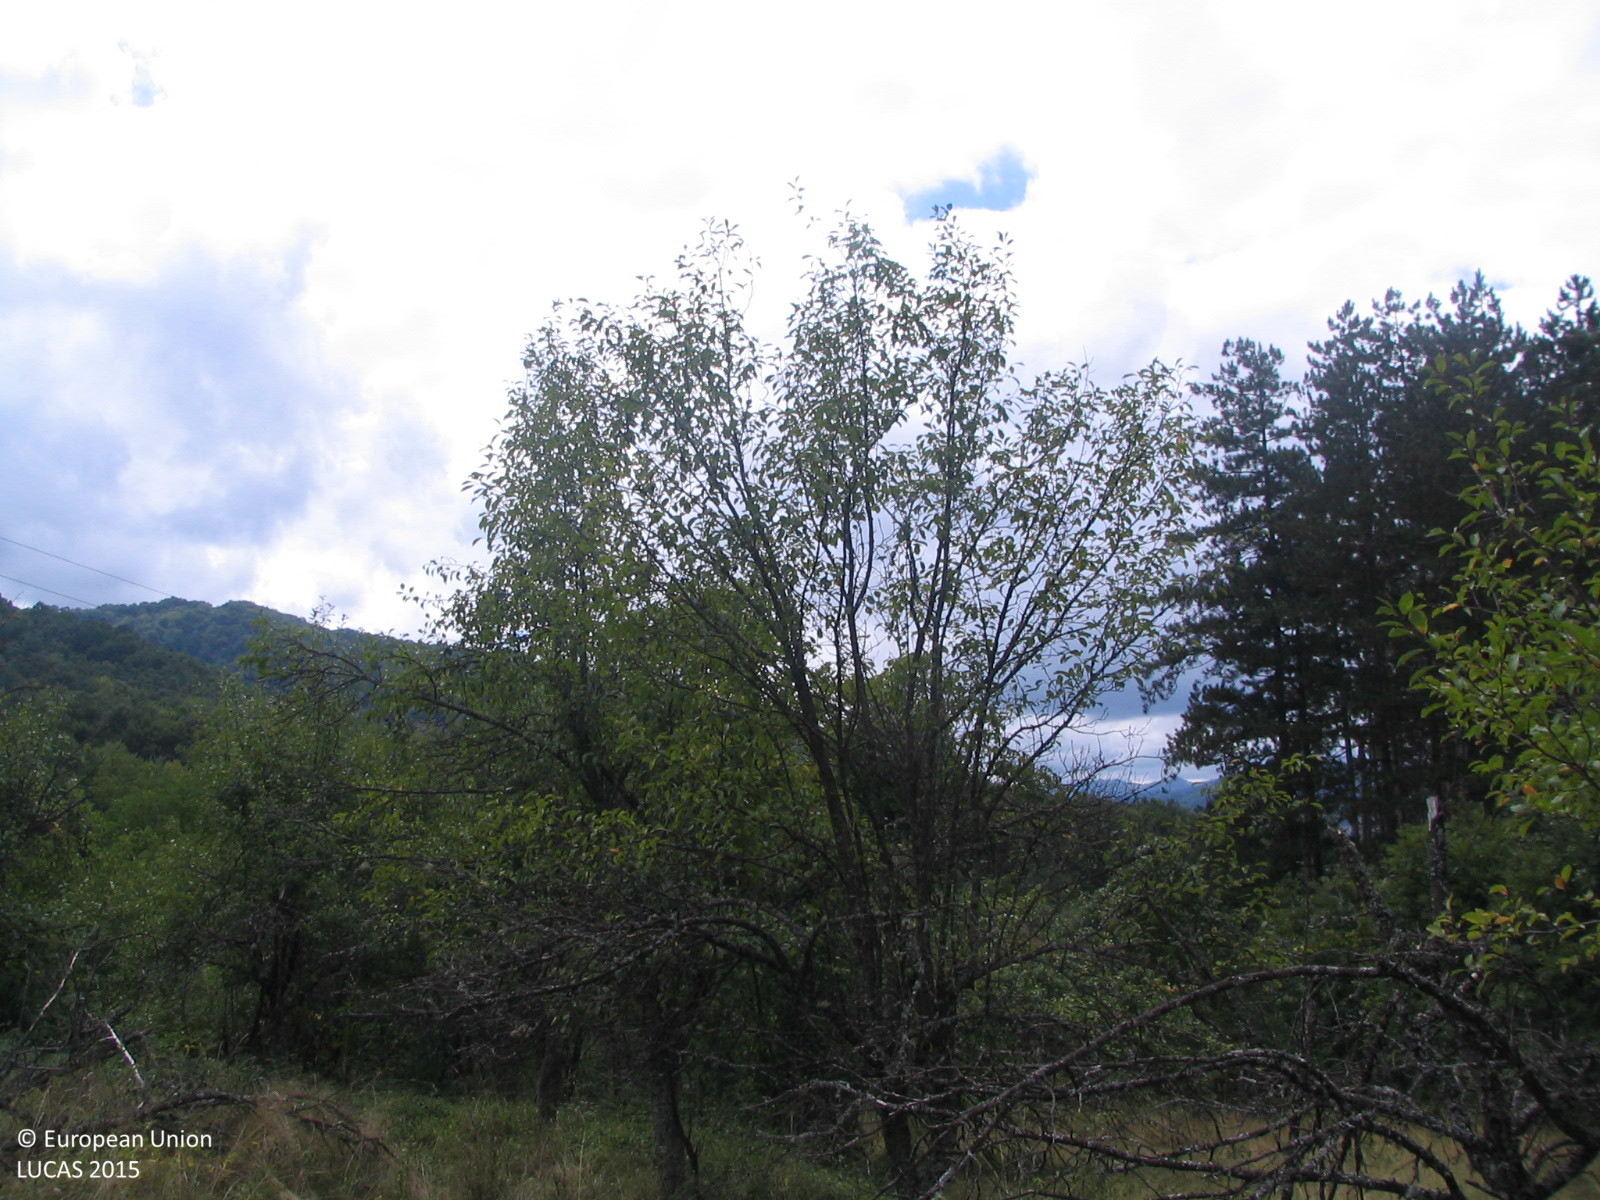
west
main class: Cropland
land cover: Other fruit trees and berries
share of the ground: 50 - 75 %
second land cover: Grassland without tree/shrub cover
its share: > 75 %
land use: Agriculture (excluding fallow land and kitchen gardens)
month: August
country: BG
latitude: 42.8704
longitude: 24.7364
